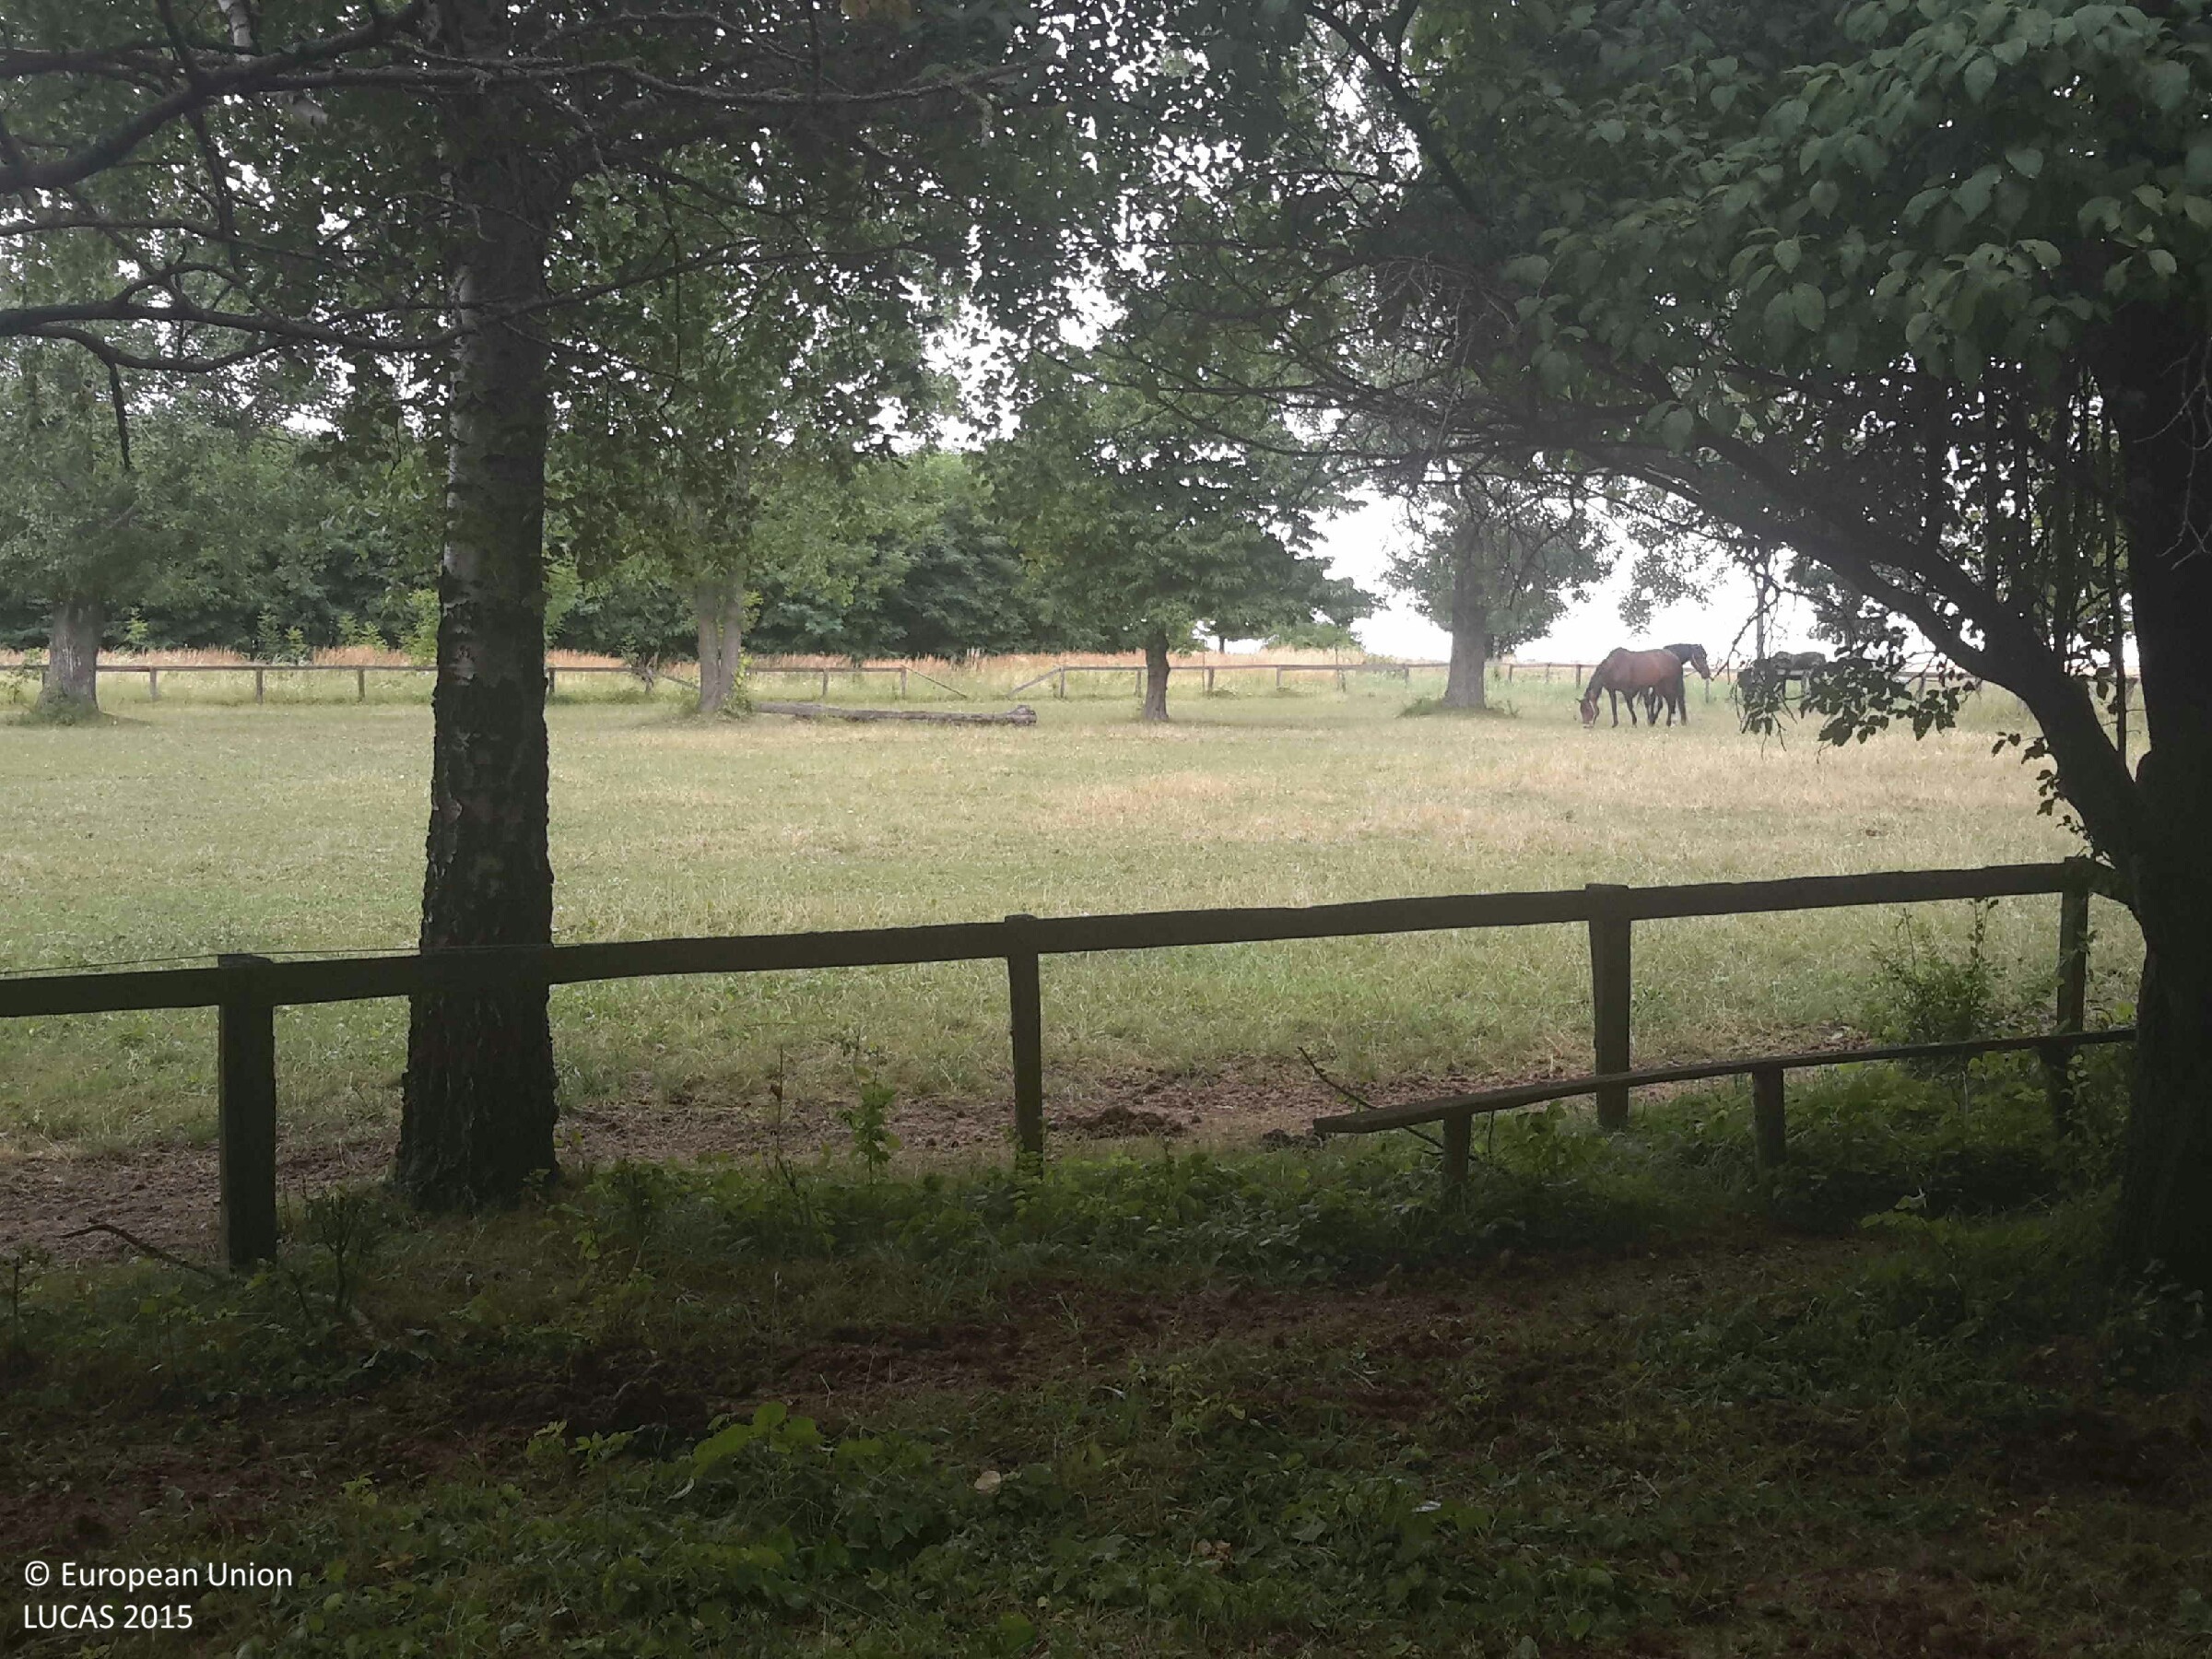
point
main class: Woodland
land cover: Broadleaved woodland
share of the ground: 25 - 50 %
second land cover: Grassland without tree/shrub cover
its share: 50 - 75 %
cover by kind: herbaceous plants 60 %, broadleaved forest trees 40 %
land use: Agriculture (excluding fallow land and kitchen gardens)
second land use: Amenities, museums, leisure
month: July
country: HU
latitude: 47.5688
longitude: 16.6908
